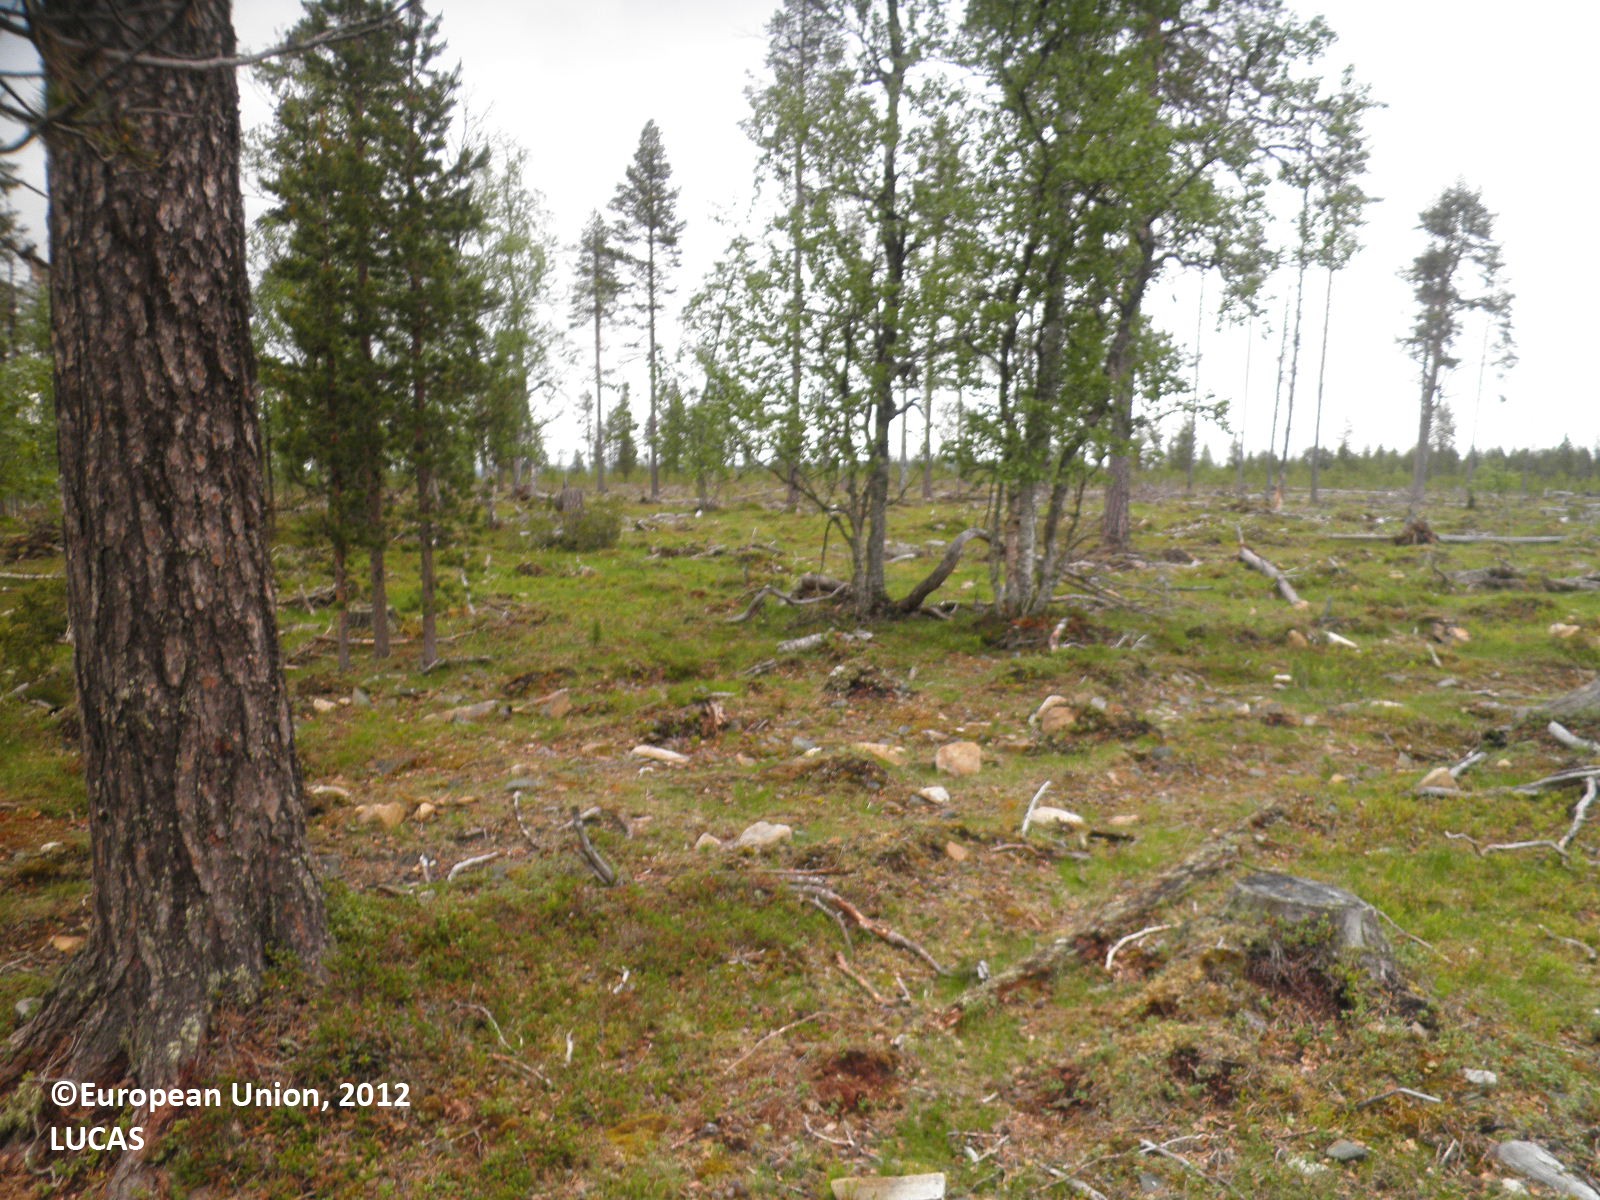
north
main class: Woodland
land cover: Pine dominated mixed woodland
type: boreal forest
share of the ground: 10 - 25 %
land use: Forestry
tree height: > 5 m
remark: Harvested field
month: July
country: FI
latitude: 68.4188
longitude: 25.8524
